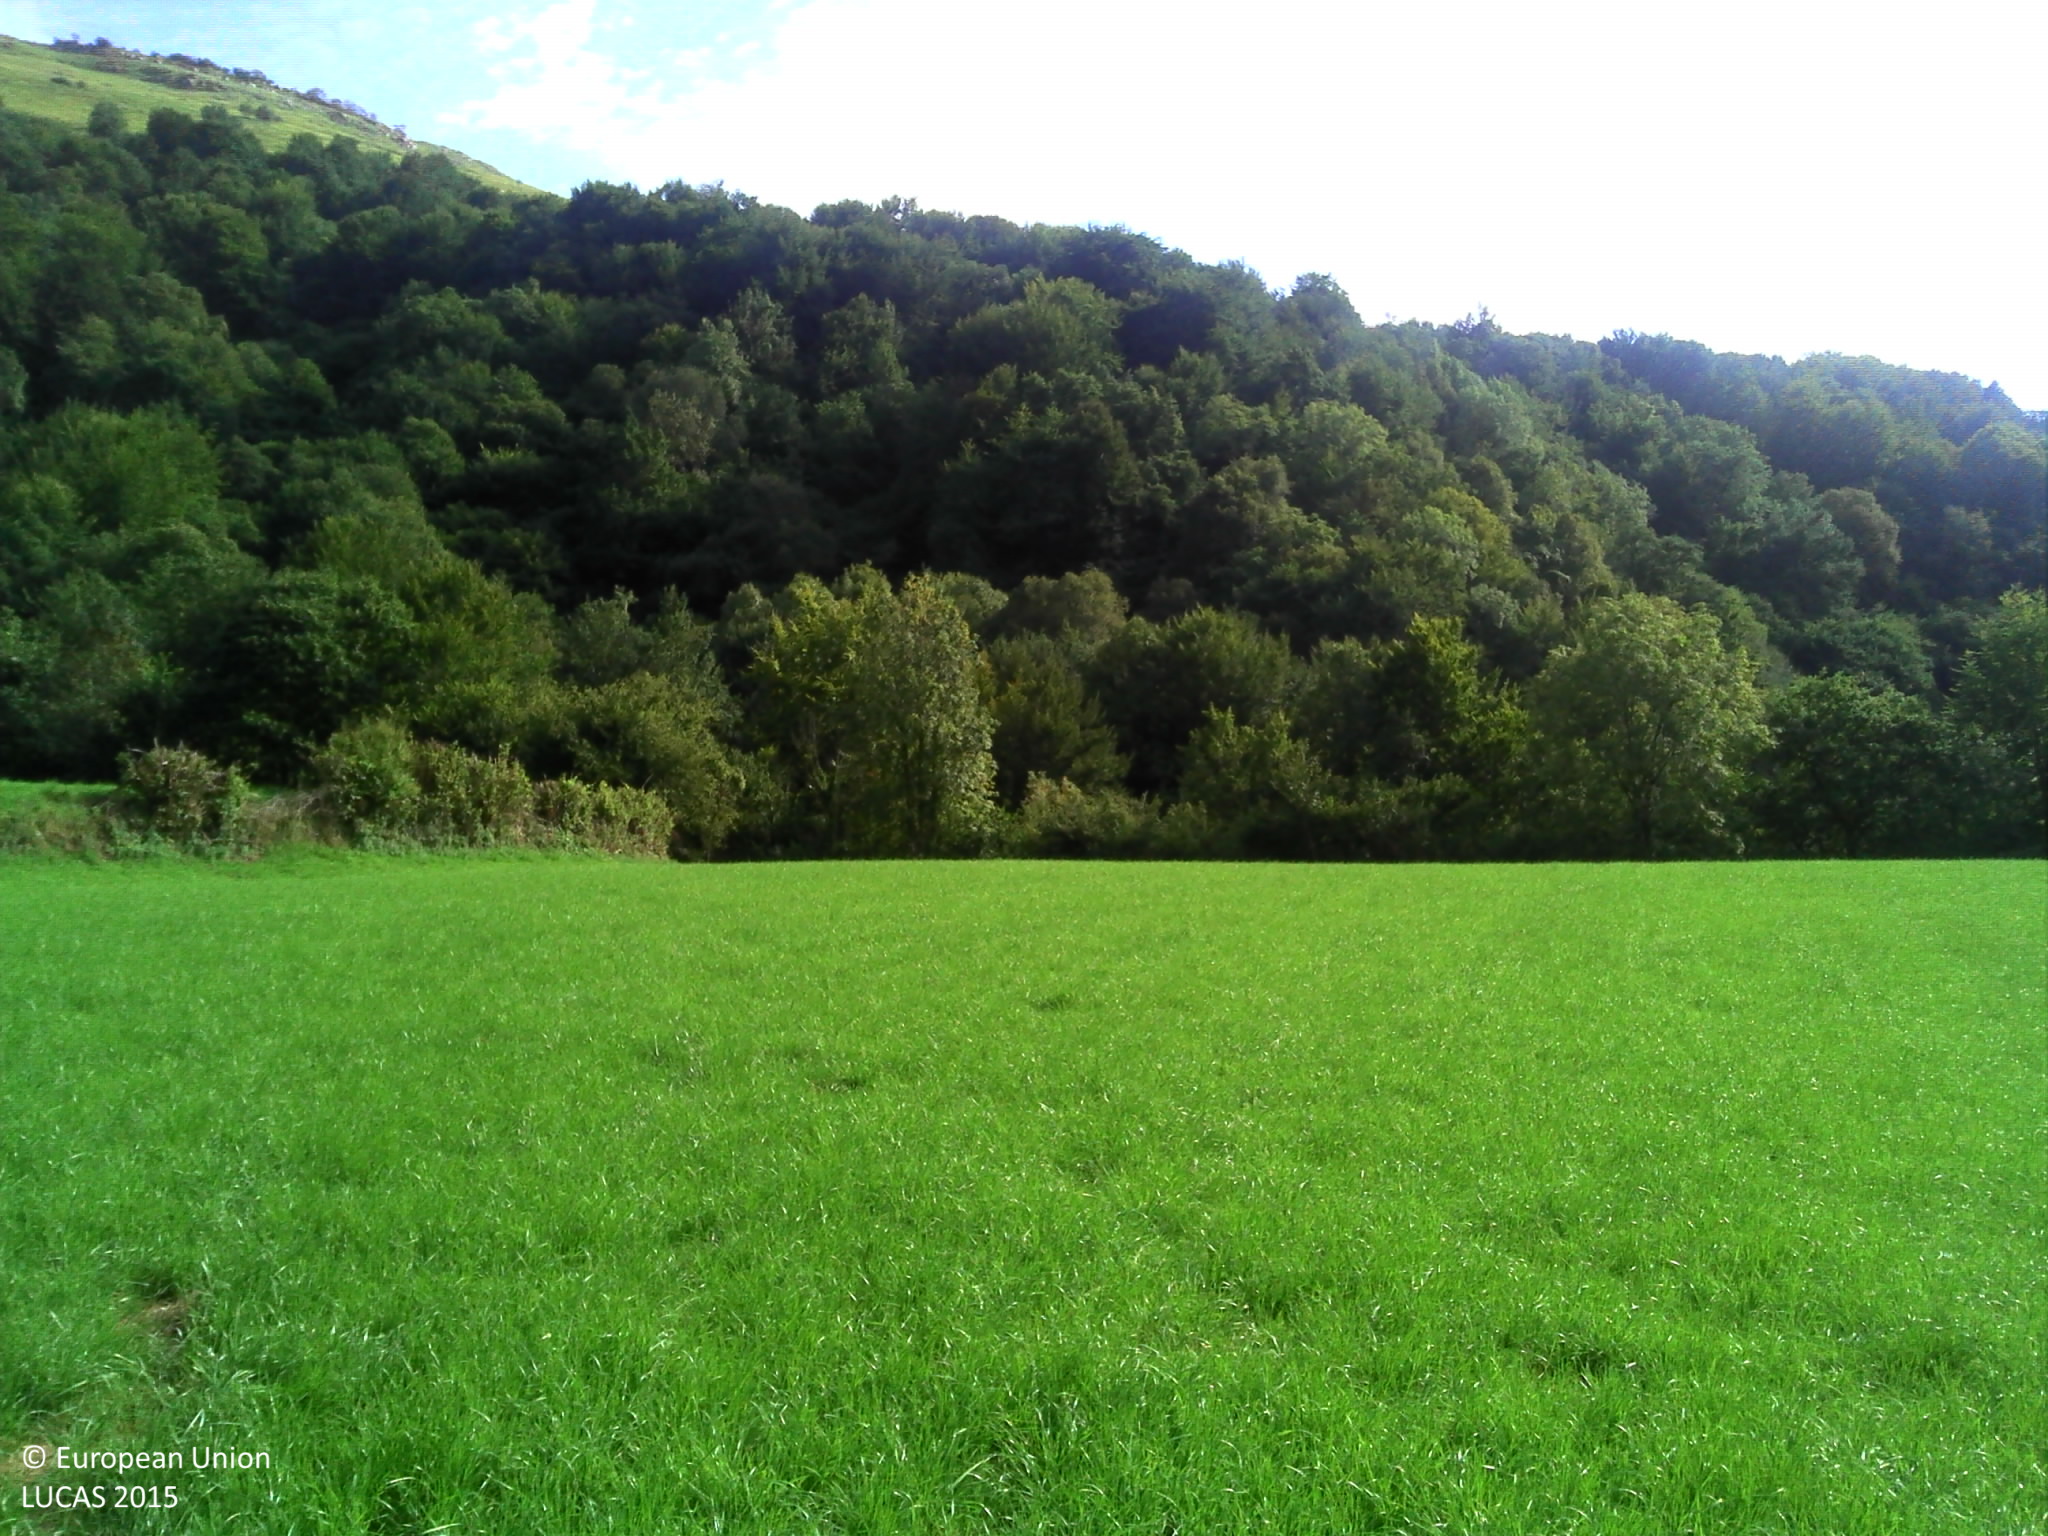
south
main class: Cropland
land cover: Temporary grasslands
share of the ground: > 75 %
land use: Agriculture (excluding fallow land and kitchen gardens)
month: September
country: FR
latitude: 43.1562
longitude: -1.0675
